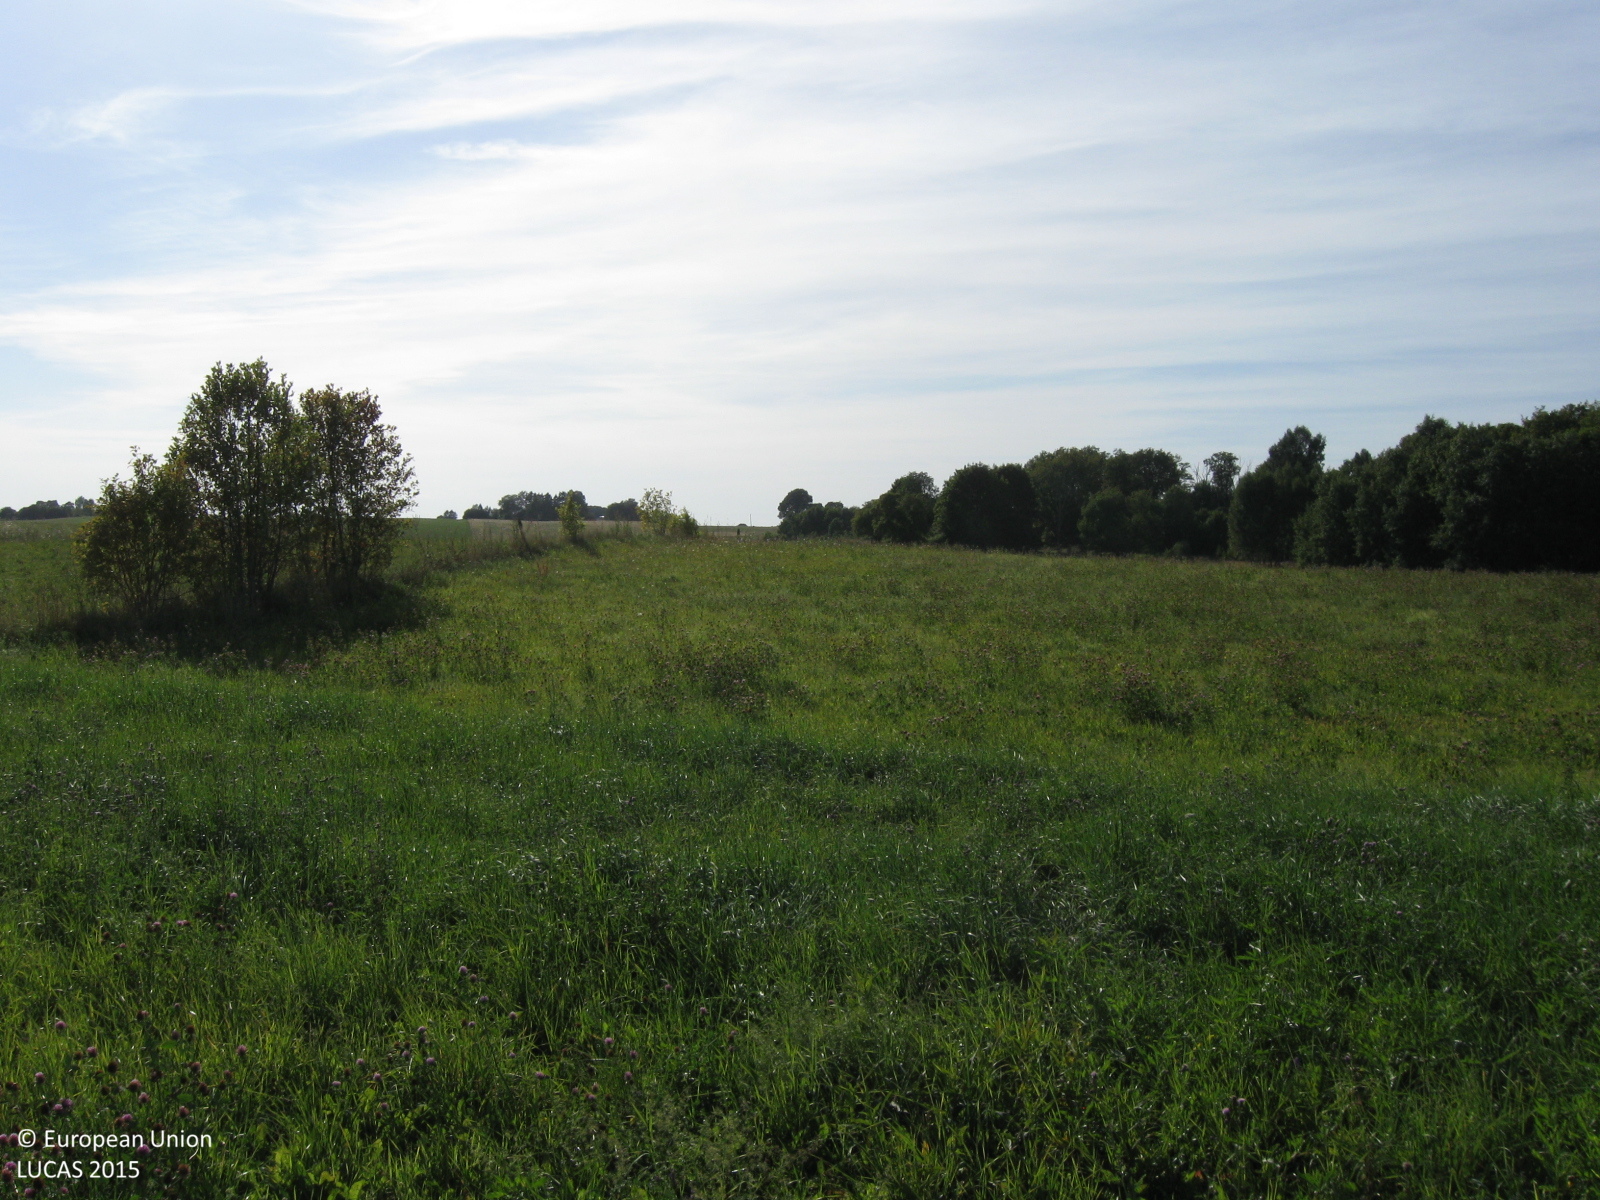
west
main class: Grassland
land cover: Grassland without tree/shrub cover
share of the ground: > 75 %
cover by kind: herbaceous plants 100 %
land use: Agriculture (excluding fallow land and kitchen gardens)
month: August
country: LT
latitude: 55.4748
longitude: 22.5765
